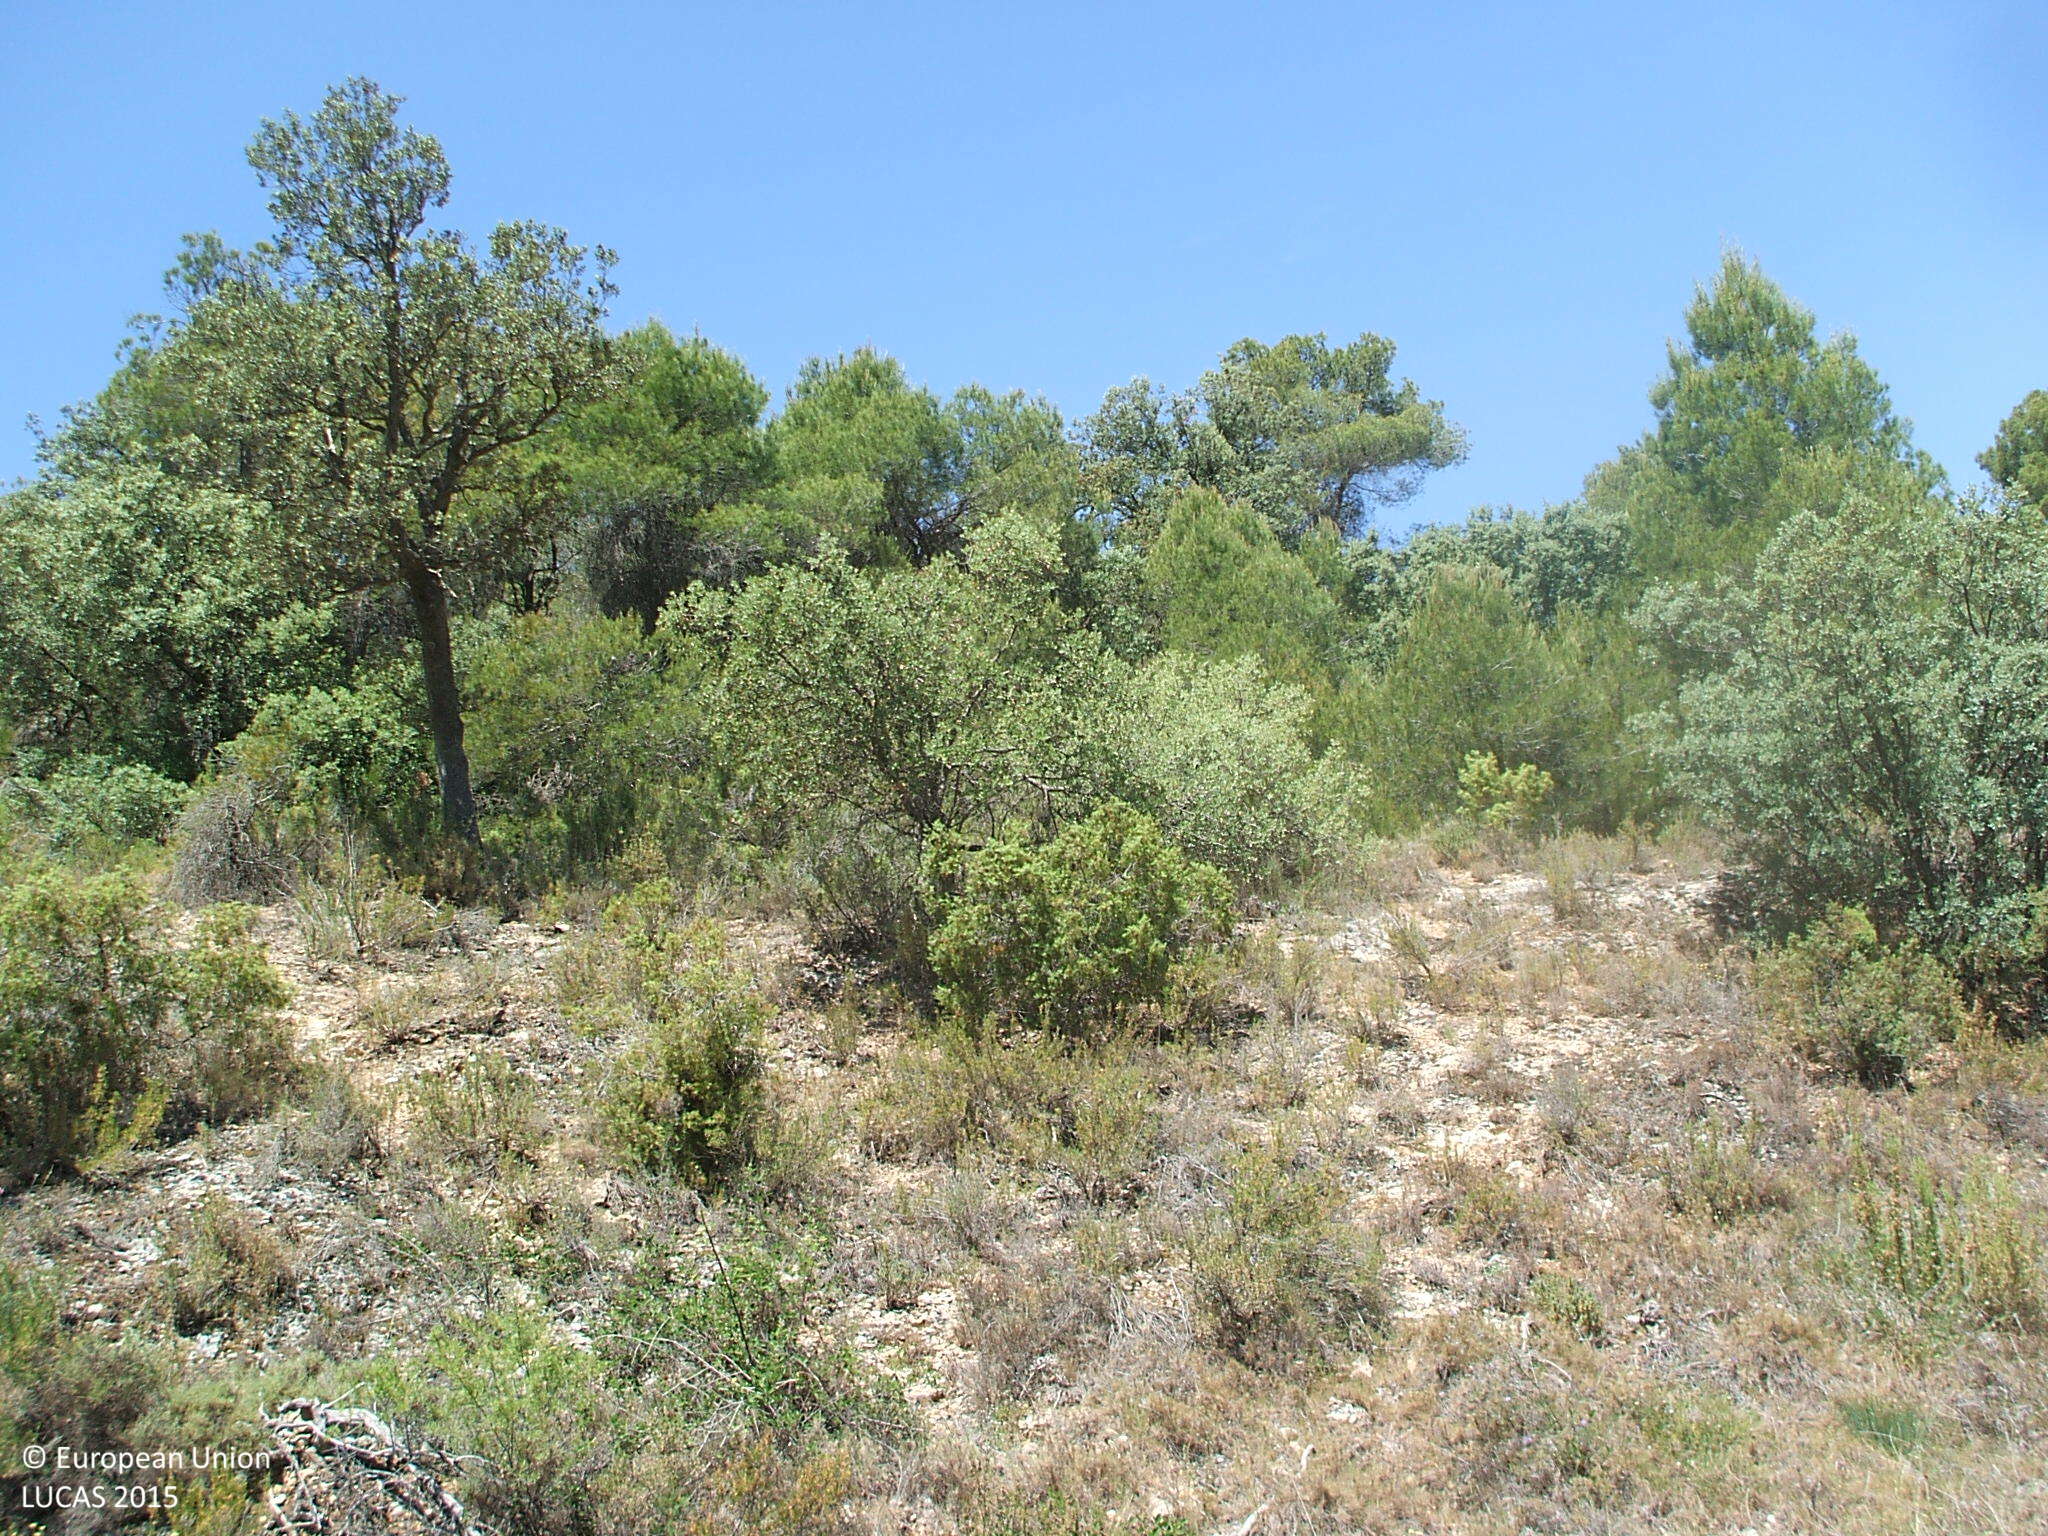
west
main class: Woodland
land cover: Pine dominated mixed woodland
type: coniferous forest of the mediterranean region
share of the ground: 50 - 75 %
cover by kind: shrubs 50 %, coniferous forest trees 25 %, broadleaved forest trees 25 %
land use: Semi-natural and natural areas not in use
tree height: > 5 m
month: June
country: ES
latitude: 40.8471
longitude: -0.0078
